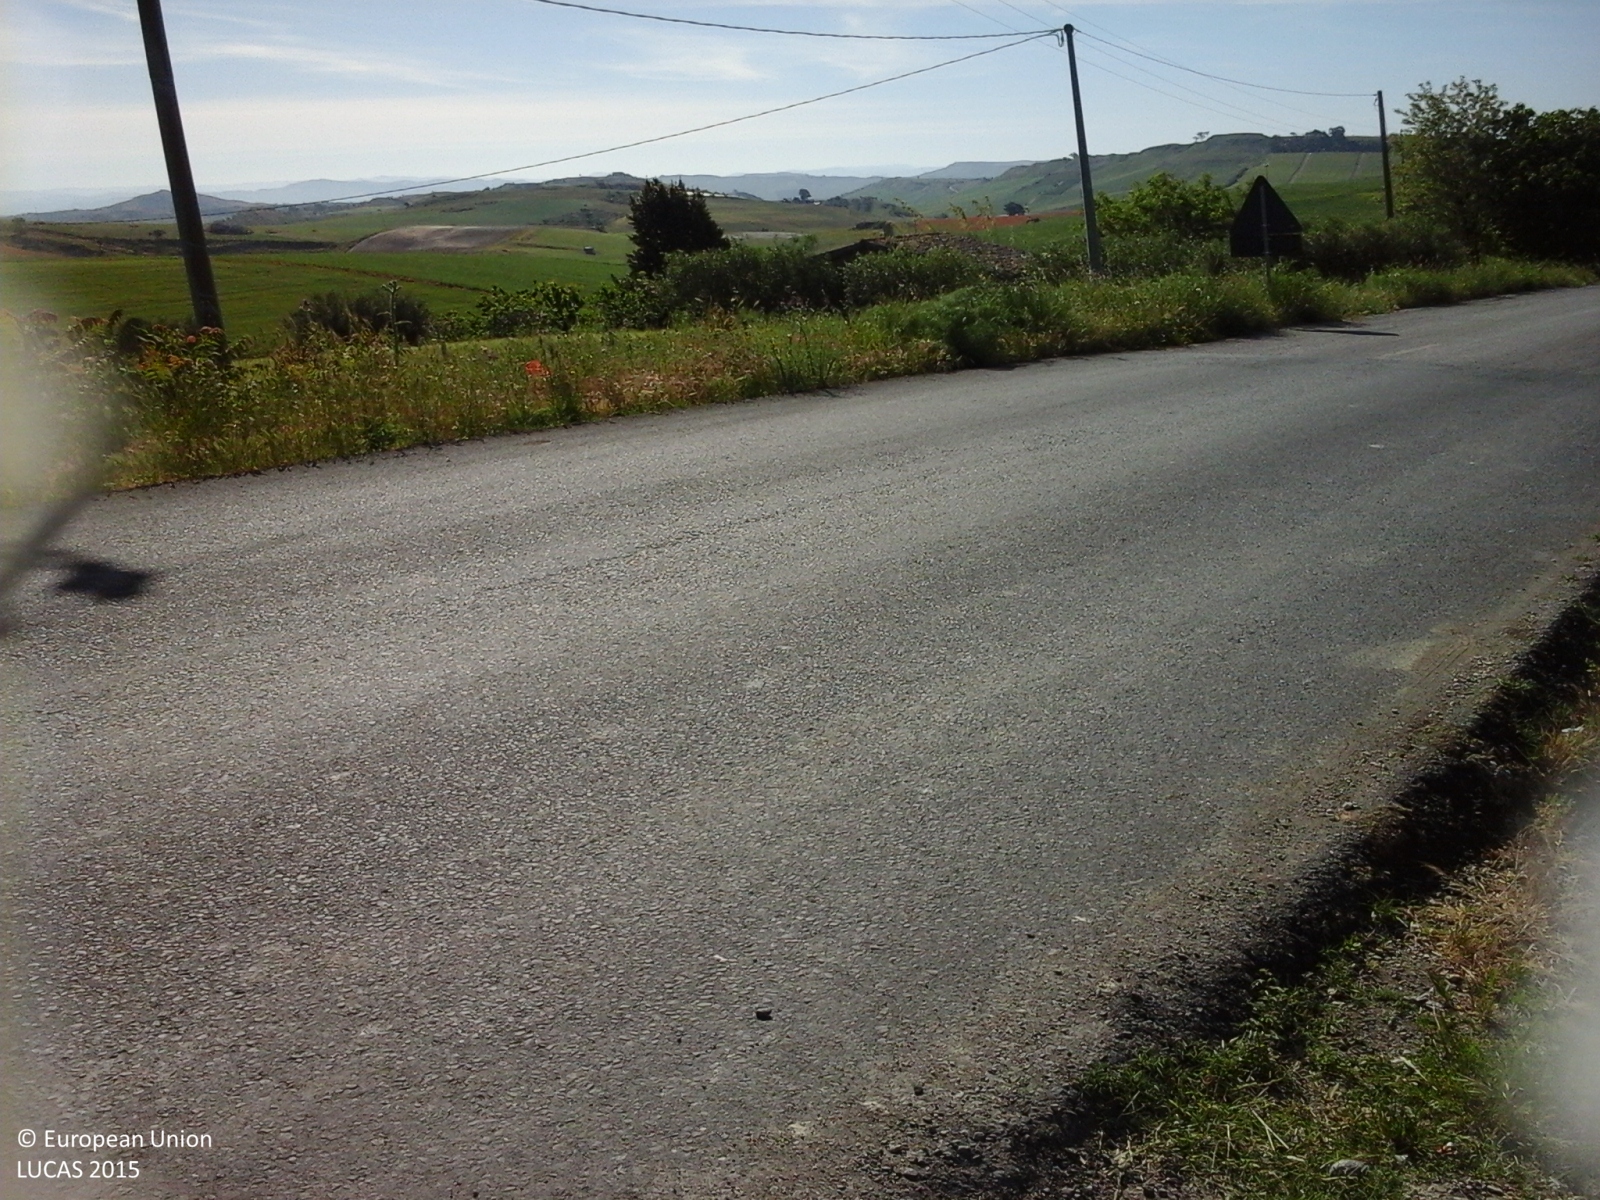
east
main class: Cropland
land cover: Vineyards
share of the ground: > 75 %
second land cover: Other bare soil
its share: > 75 %
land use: Agriculture (excluding fallow land and kitchen gardens)
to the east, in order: Vineyards; Other bare soil; Grass margins; Olive groves; Vineyards; Tracks; Grass margins; Olive groves
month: May
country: IT
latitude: 37.4126
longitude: 13.9133
